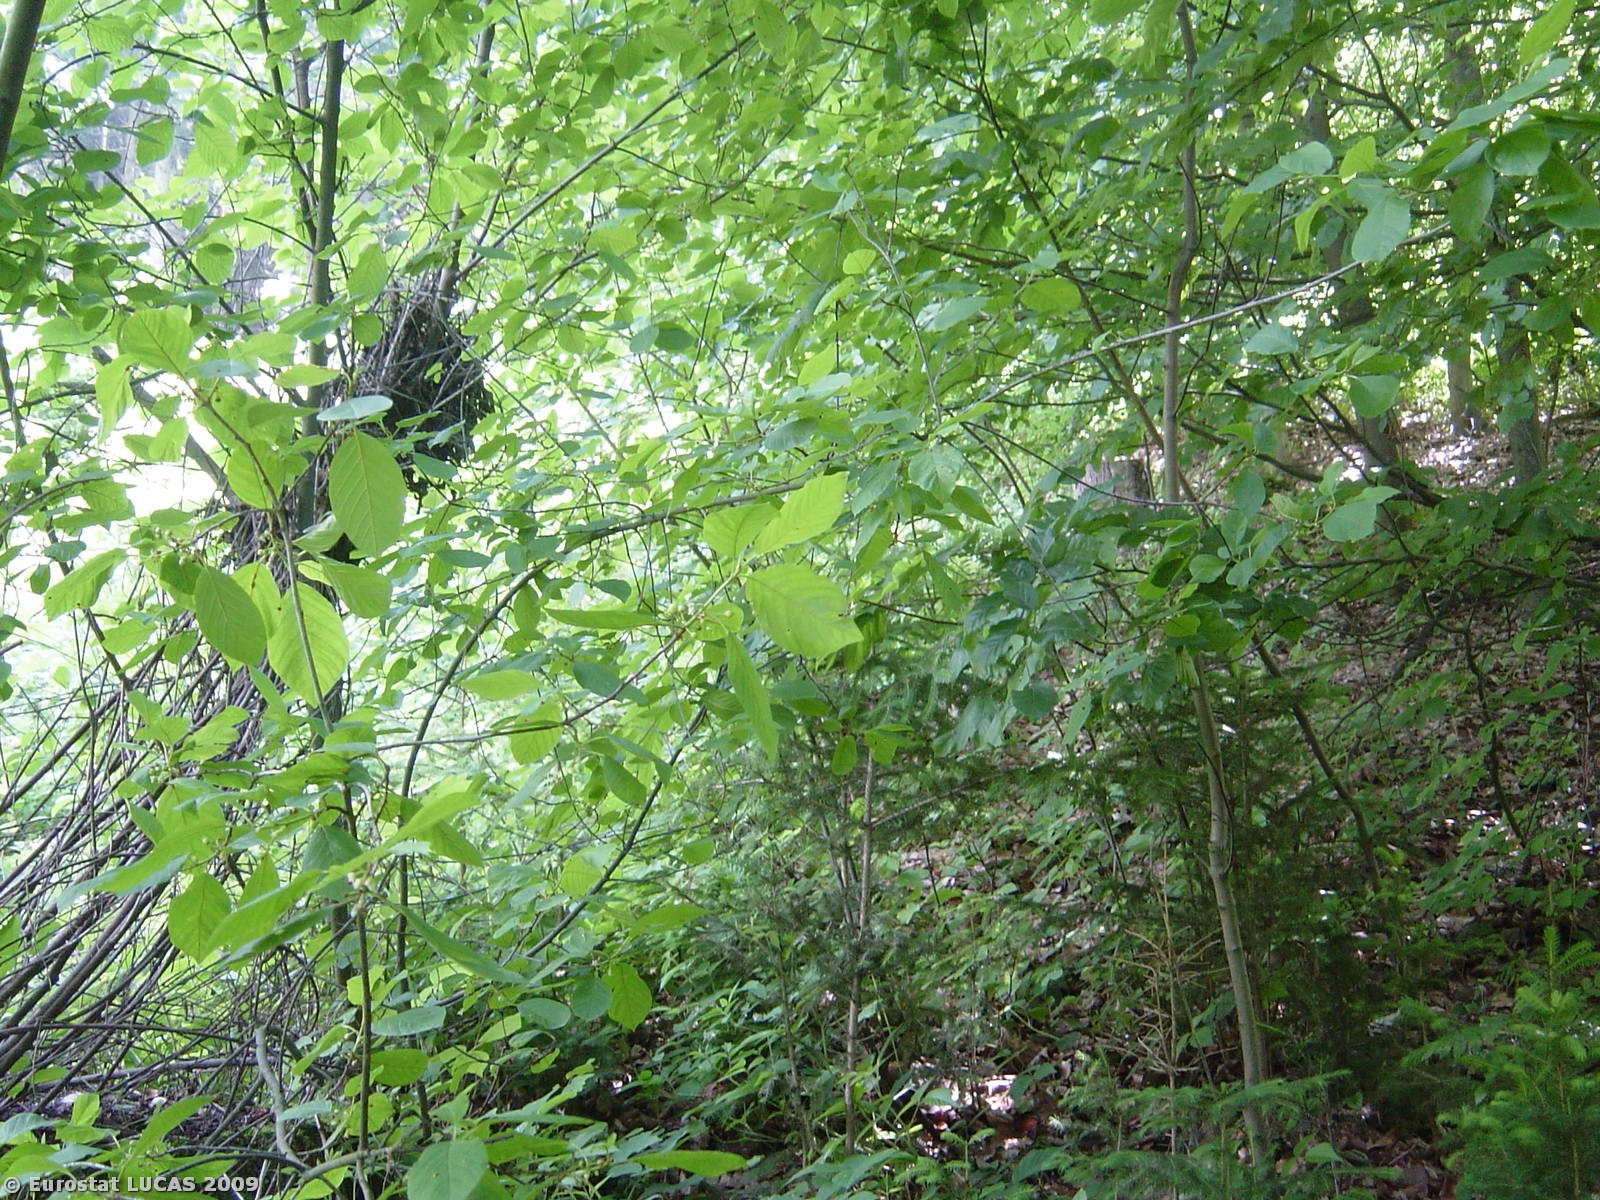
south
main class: Woodland
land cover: Mixed woodland
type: hemiboreal forest and nemoral coniferous forest and mixed broadleaved-coniferous forest
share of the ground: > 75 %
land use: Forestry
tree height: > 5 m
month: June
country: CZ
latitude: 49.8169
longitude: 16.5258
